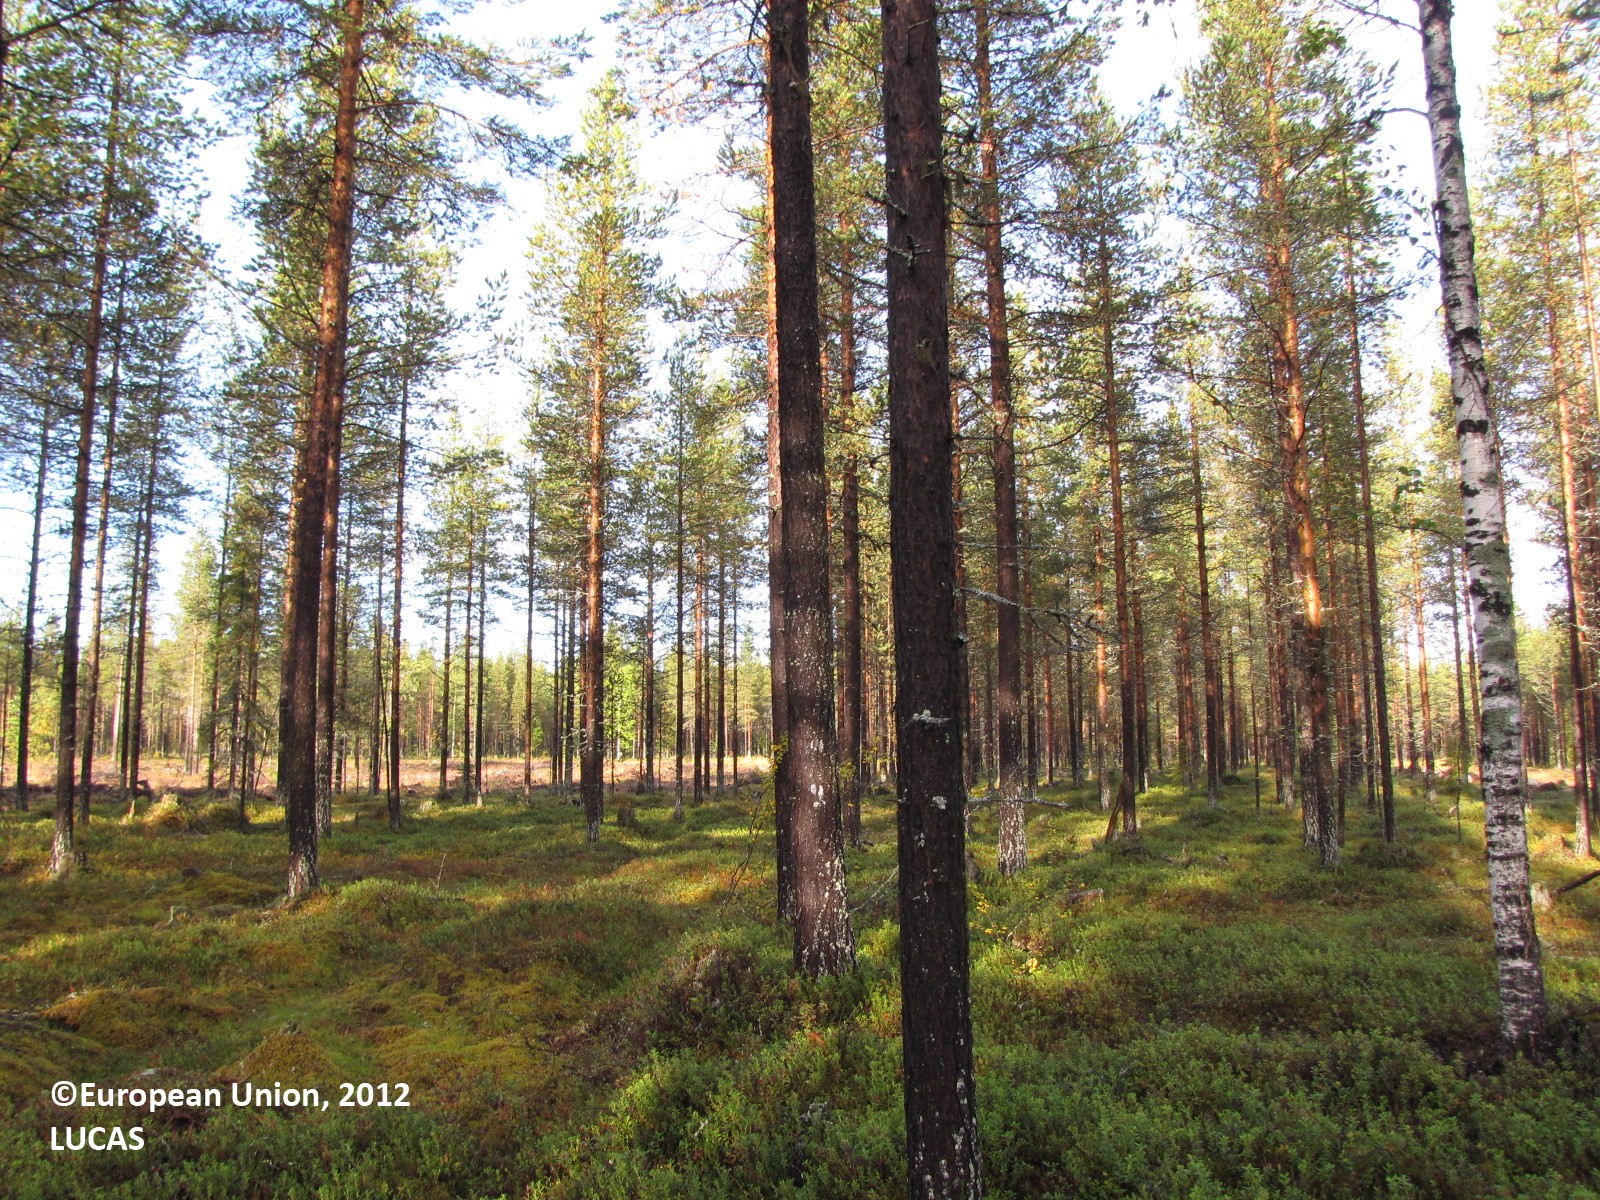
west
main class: Woodland
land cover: Pine dominated coniferous woodland
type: boreal forest
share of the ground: 50 - 75 %
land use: Forestry
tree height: > 5 m
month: September
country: FI
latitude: 67.2491
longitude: 25.4142
